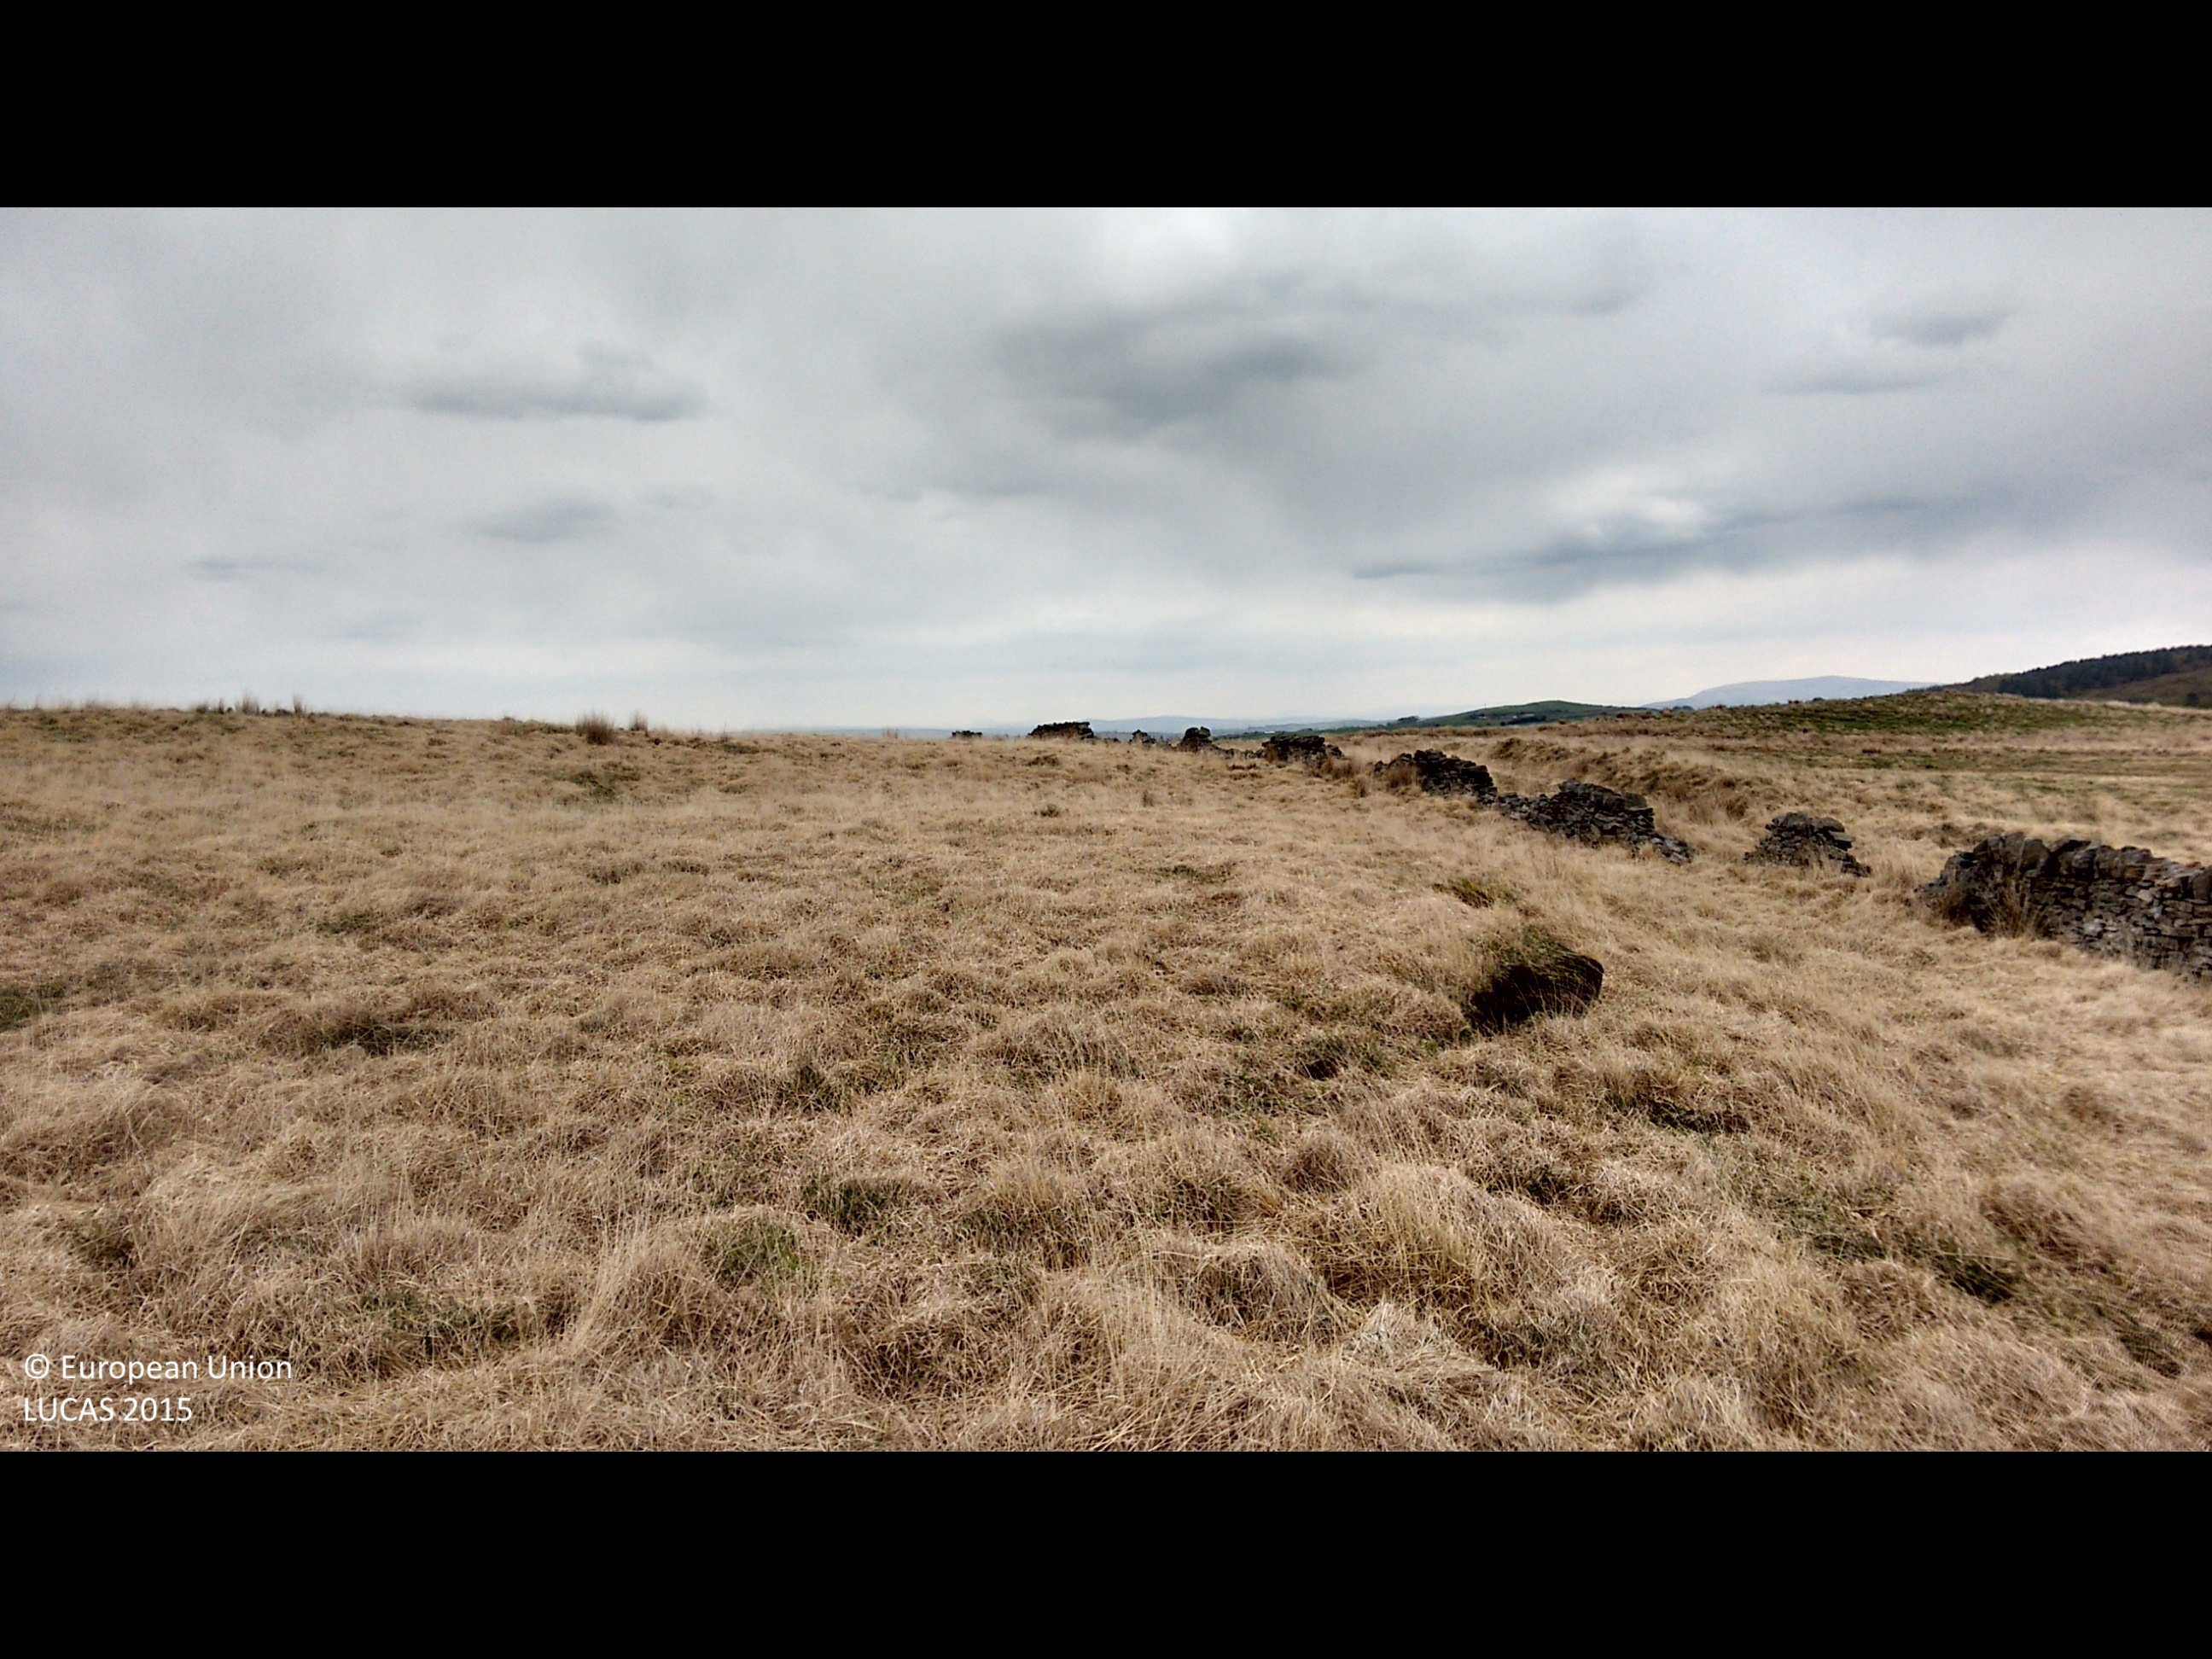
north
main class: Grassland
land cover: Grassland without tree/shrub cover
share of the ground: > 75 %
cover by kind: herbaceous plants 100 %
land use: Agriculture (excluding fallow land and kitchen gardens)
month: May
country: GB
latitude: 53.6769
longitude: -2.5247
